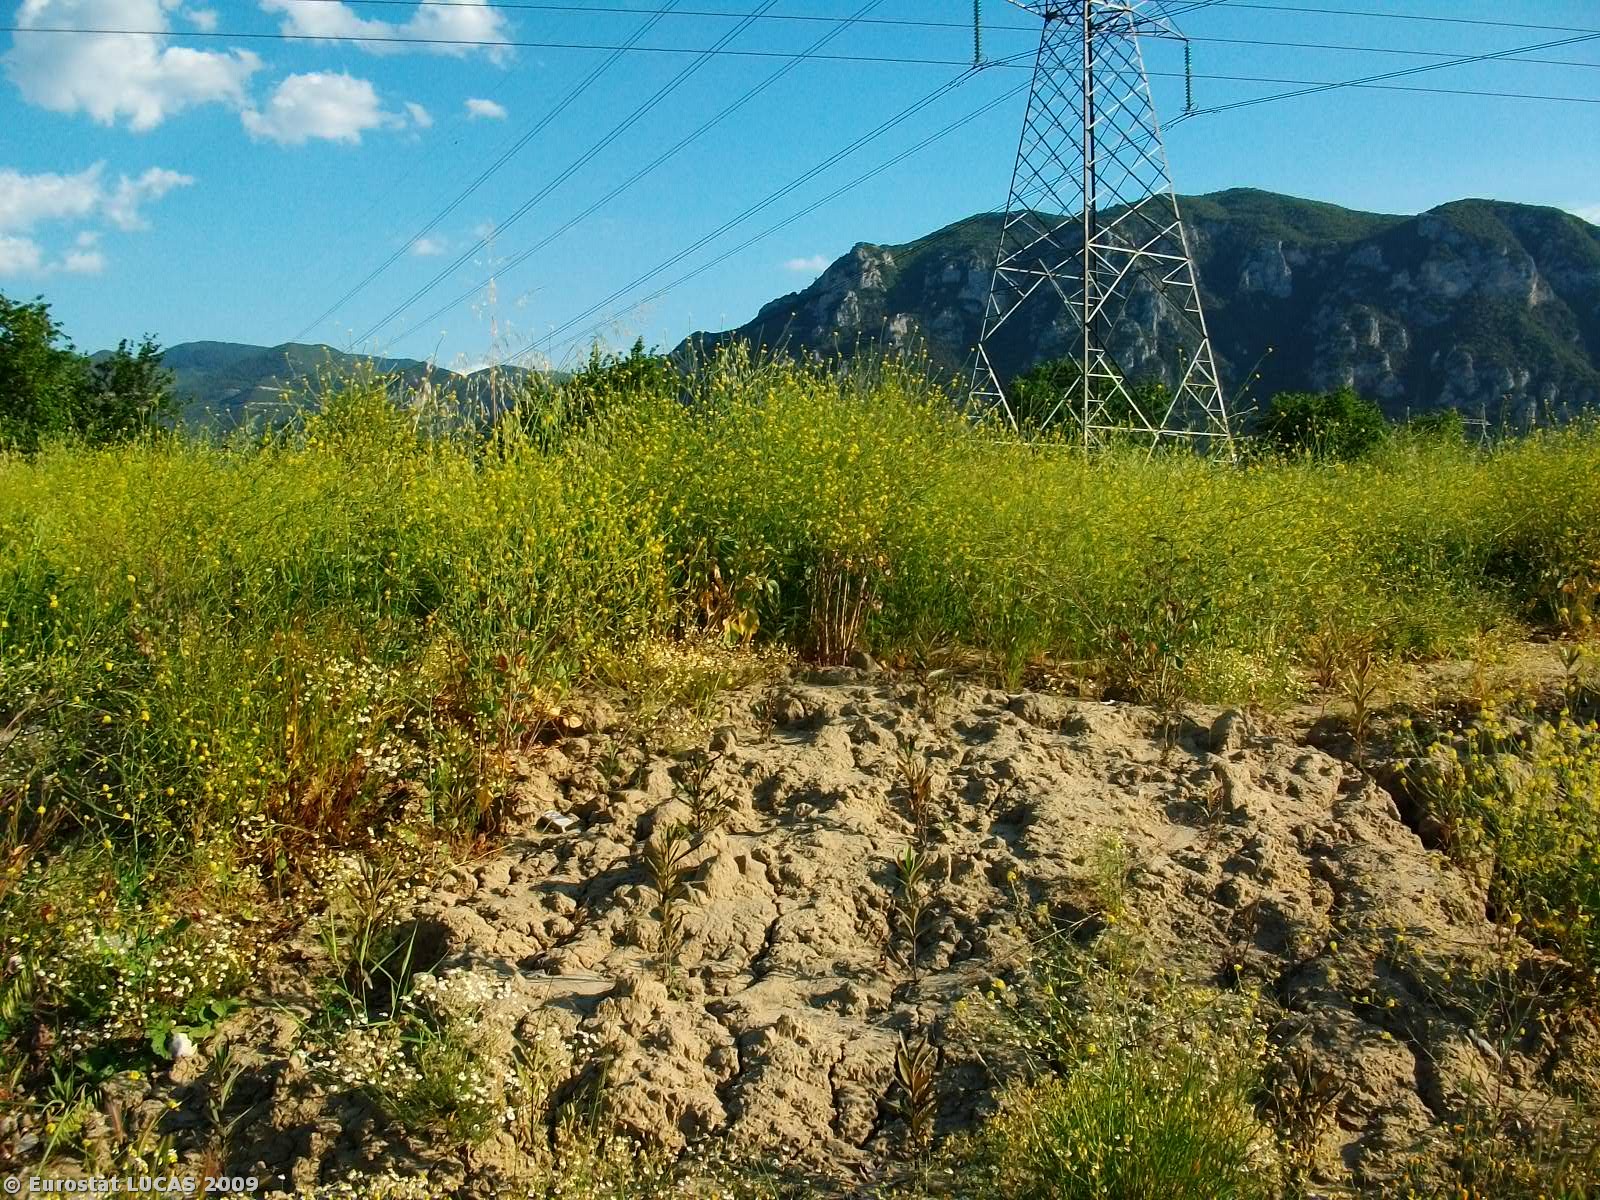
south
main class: Cropland
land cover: Olive groves
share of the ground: 50 - 75 %
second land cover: Grassland with sparse tree/shrub cover
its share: 50 - 75 %
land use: Agriculture (excluding fallow land and kitchen gardens)
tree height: < 5 m
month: May
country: GR
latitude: 38.8151
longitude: 22.4292
